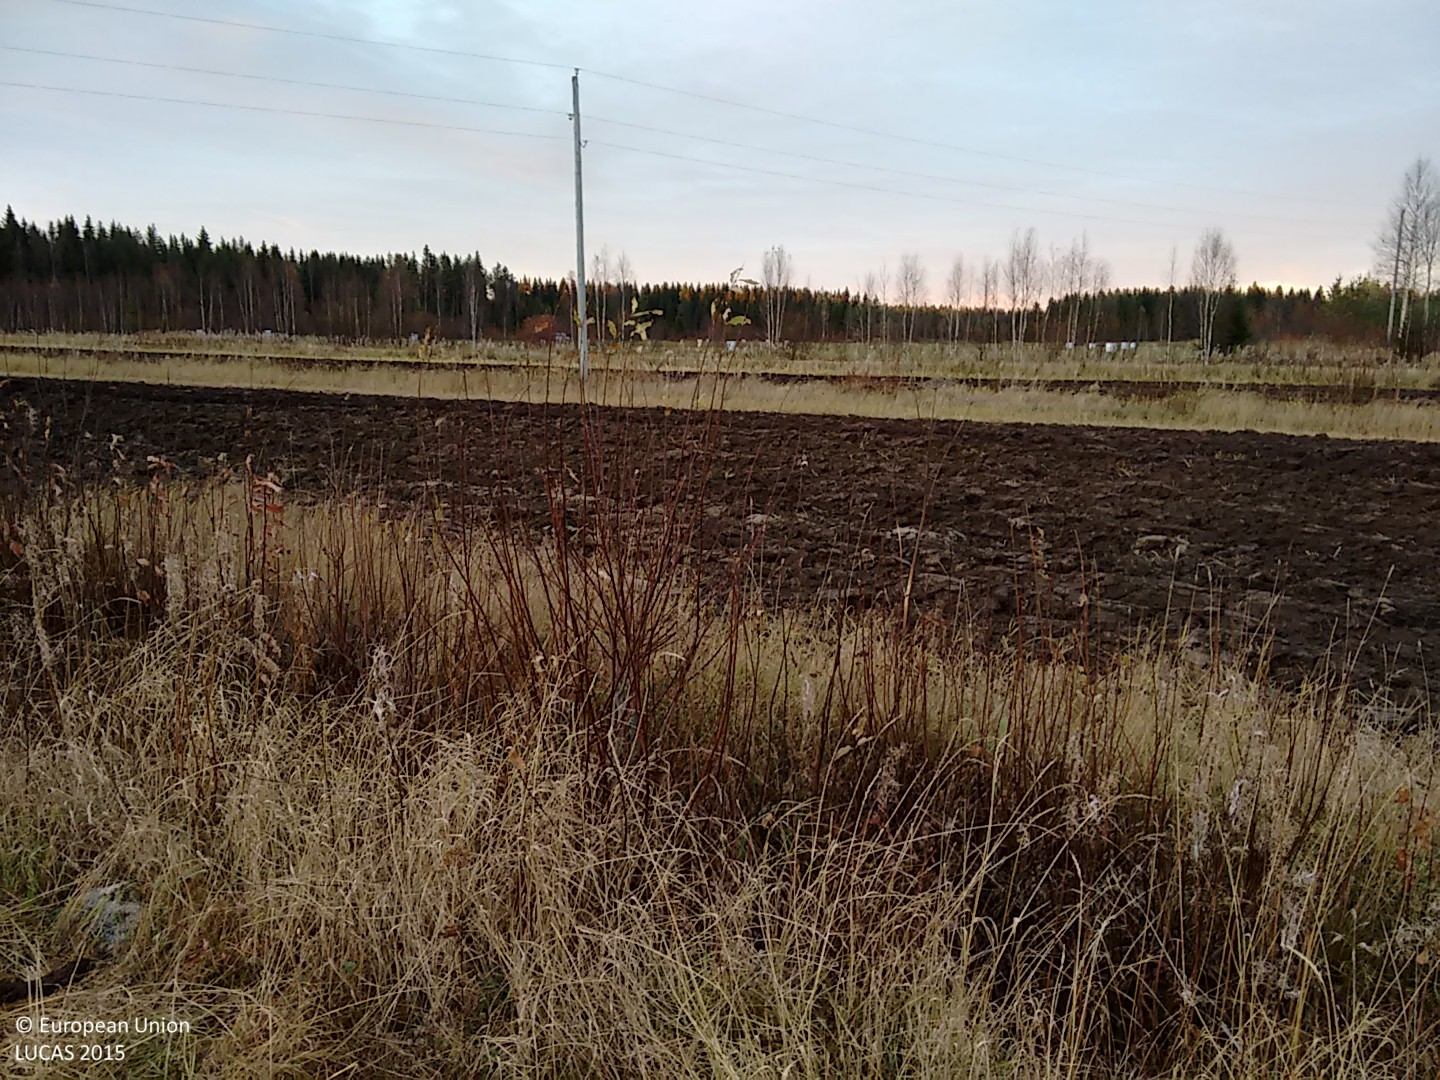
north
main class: Cropland
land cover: Oats
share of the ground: < 10 %
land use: Agriculture (excluding fallow land and kitchen gardens)
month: October
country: FI
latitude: 64.6350
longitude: 24.6530
